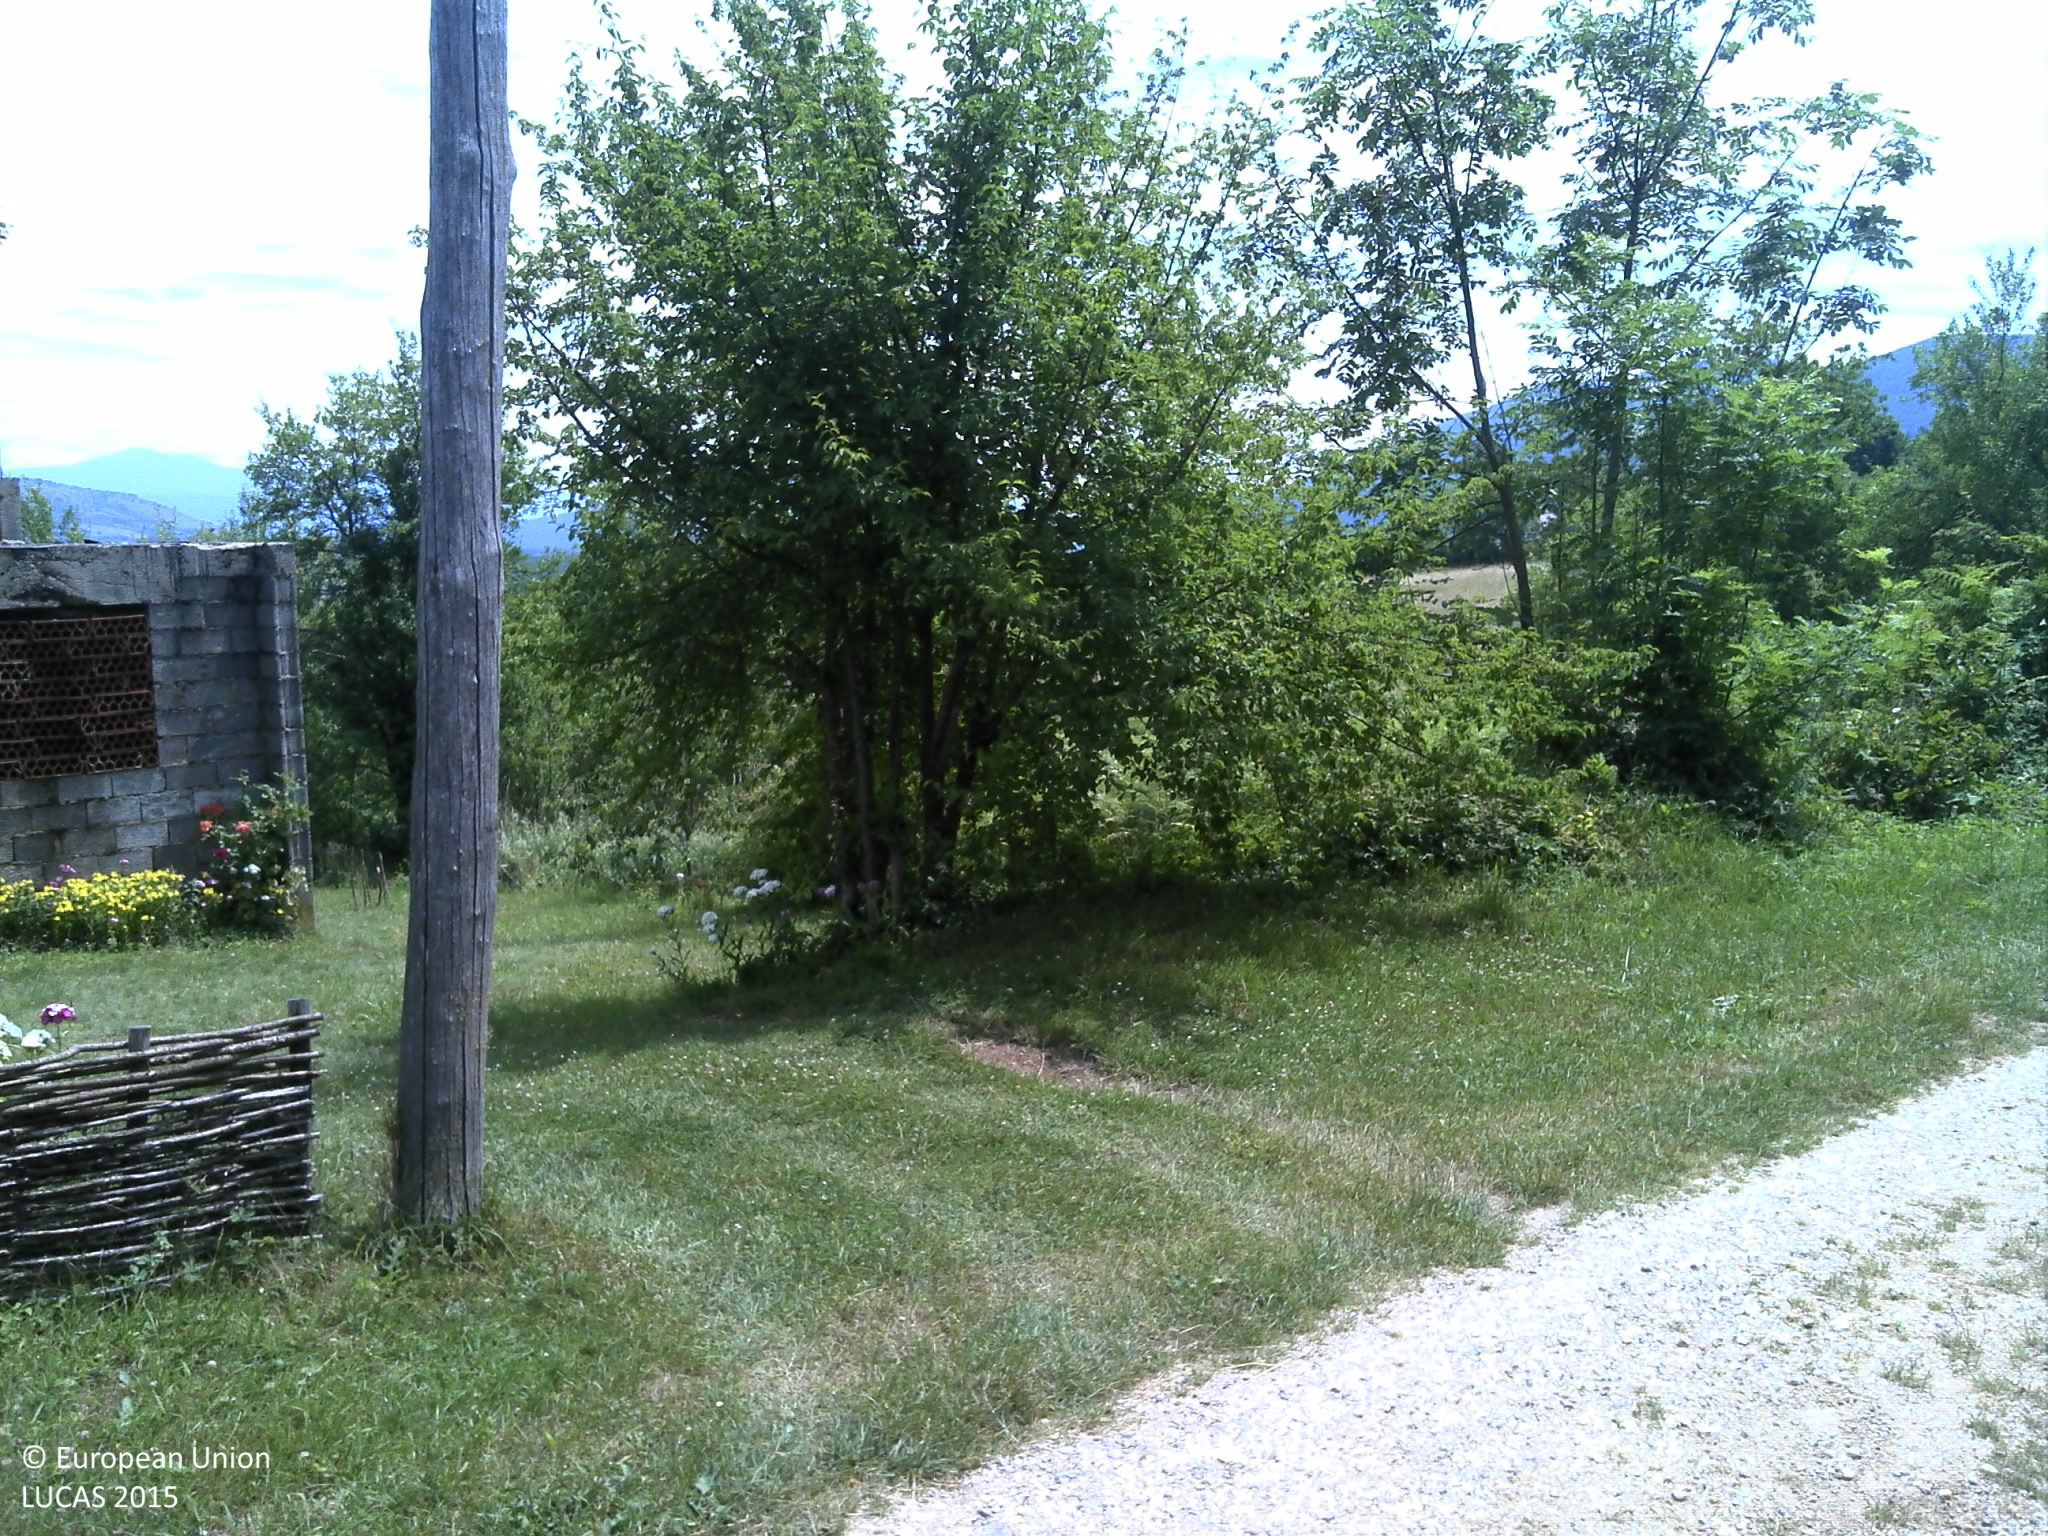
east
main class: Woodland
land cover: Broadleaved woodland
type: beech forest
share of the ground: > 75 %
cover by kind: broadleaved forest trees 100 %
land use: Semi-natural and natural areas not in use
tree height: > 5 m
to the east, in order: Broadleaved woodland
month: June
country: HR
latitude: 44.5430
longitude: 15.9220
